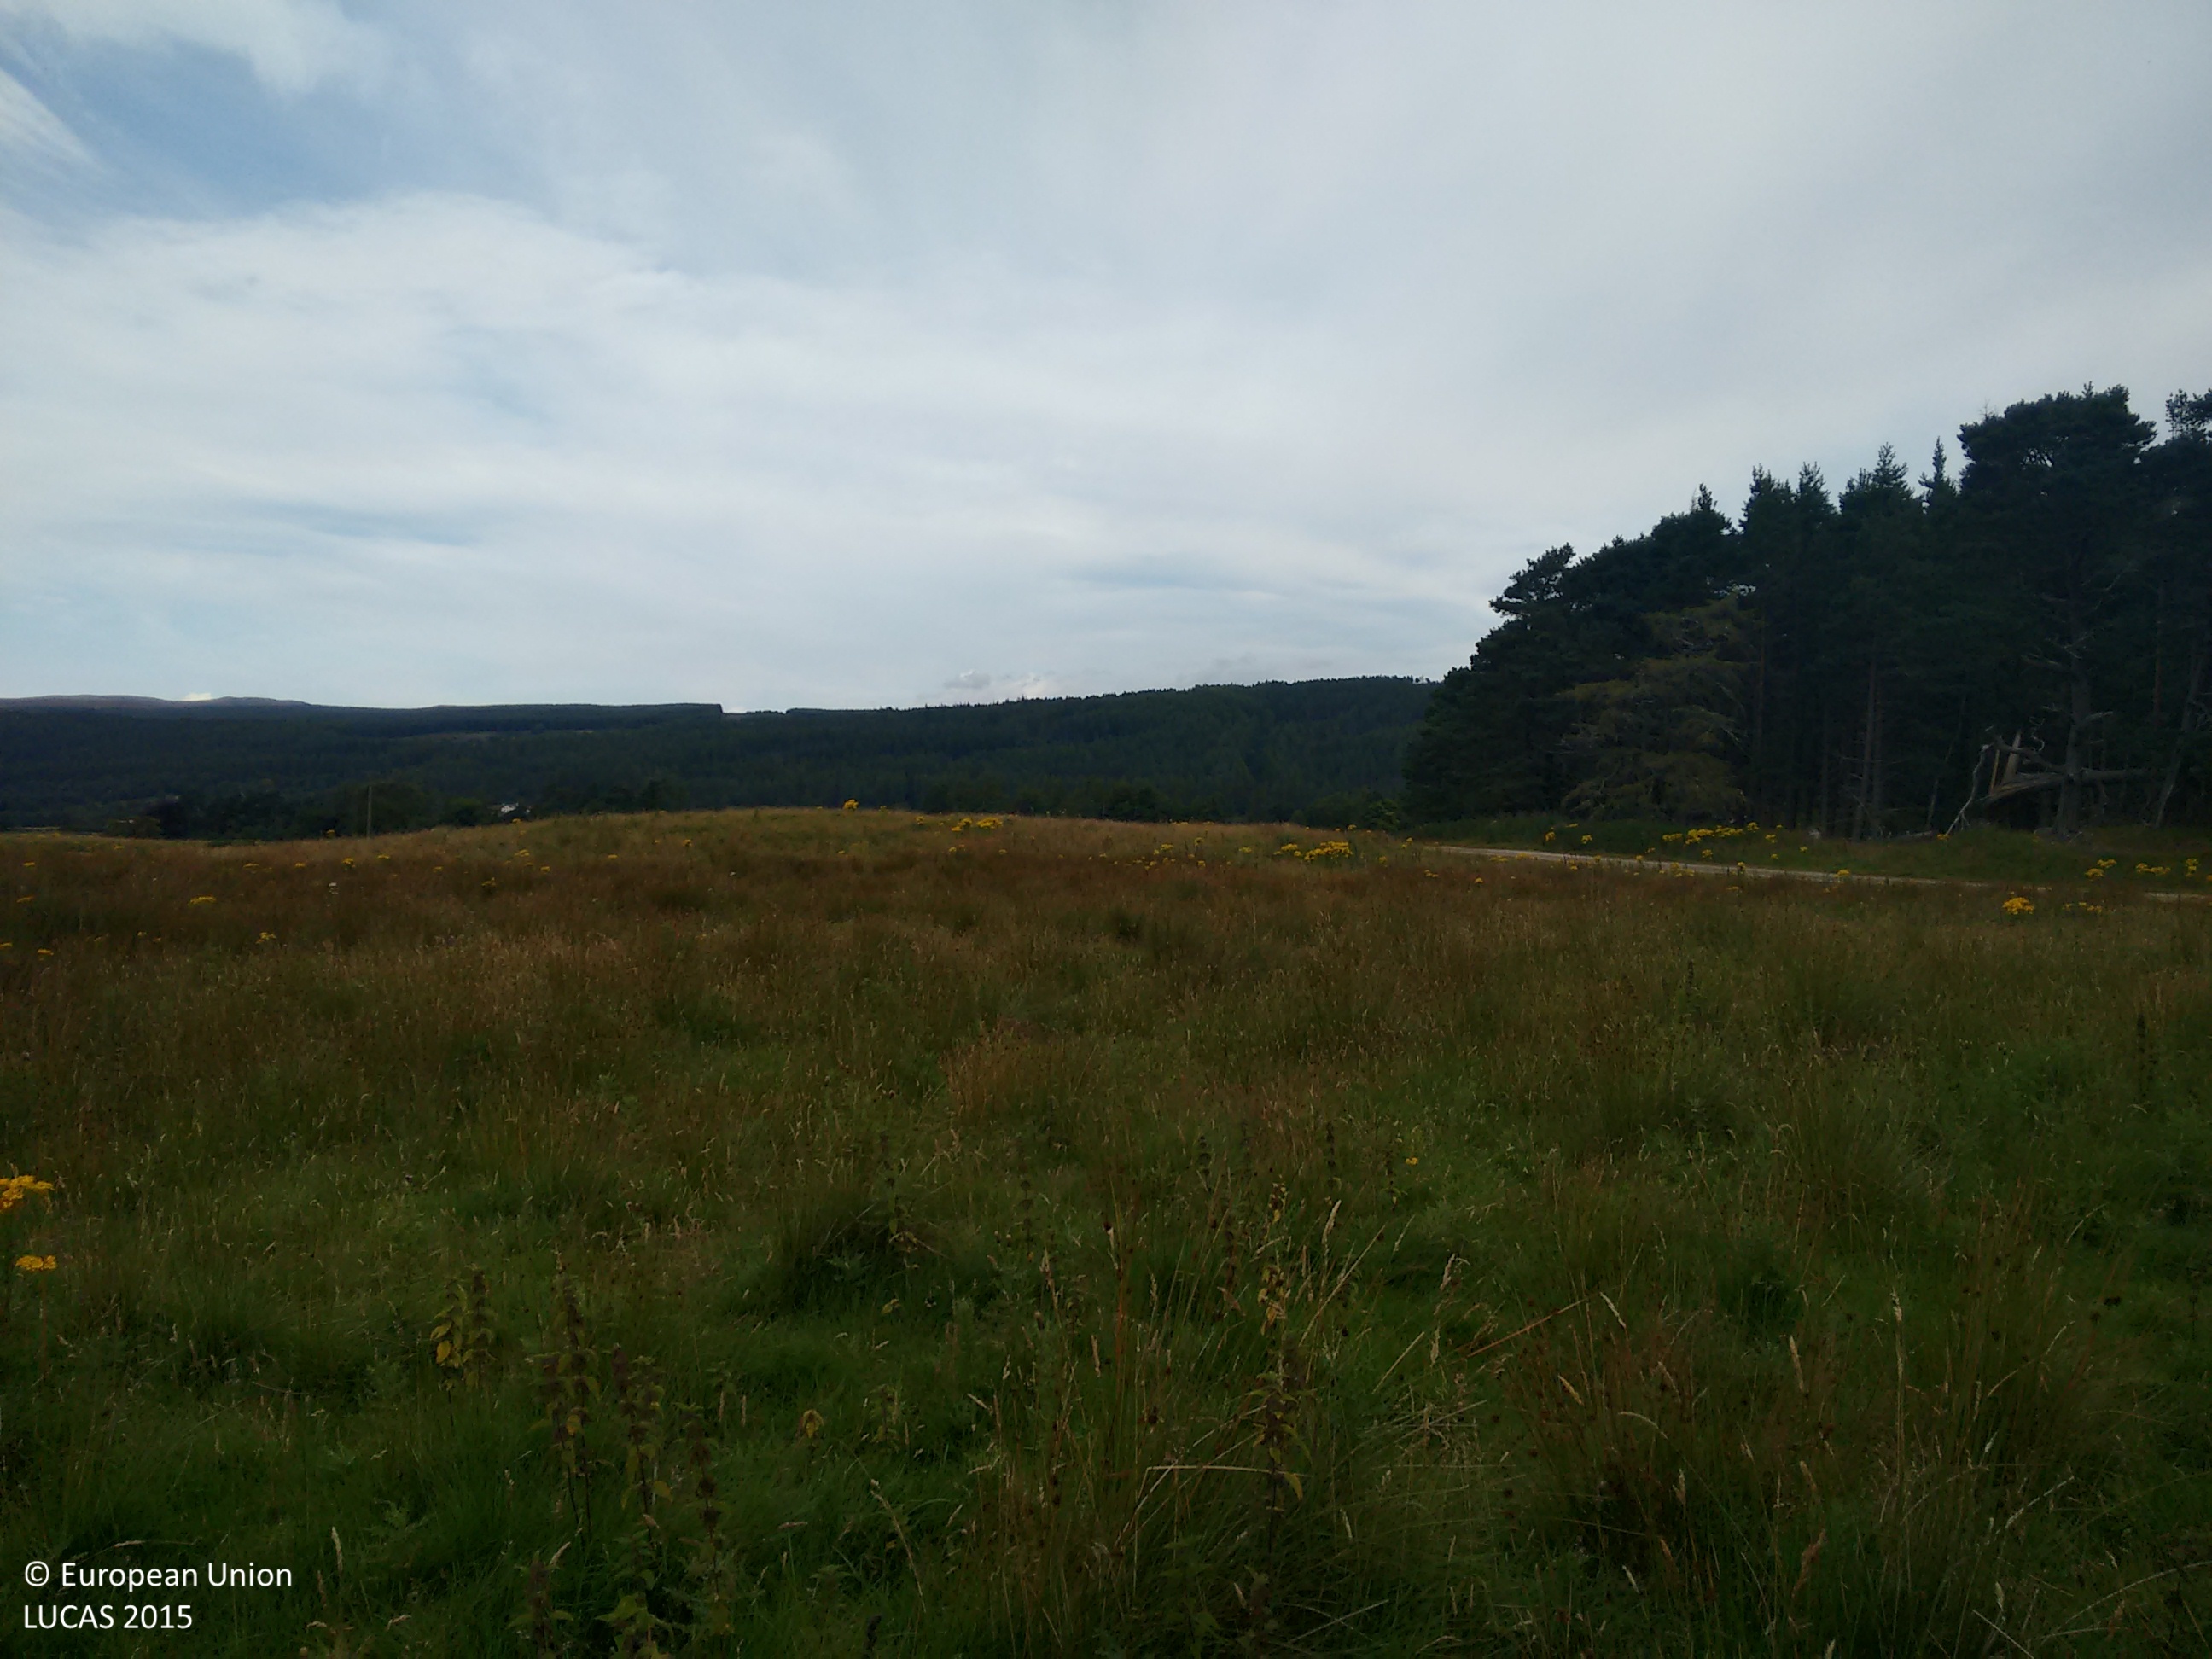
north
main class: Grassland
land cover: Grassland without tree/shrub cover
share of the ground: > 75 %
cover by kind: herbaceous plants 100 %
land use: Agriculture (excluding fallow land and kitchen gardens)
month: September
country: GB
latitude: 57.8776
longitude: -4.4024
